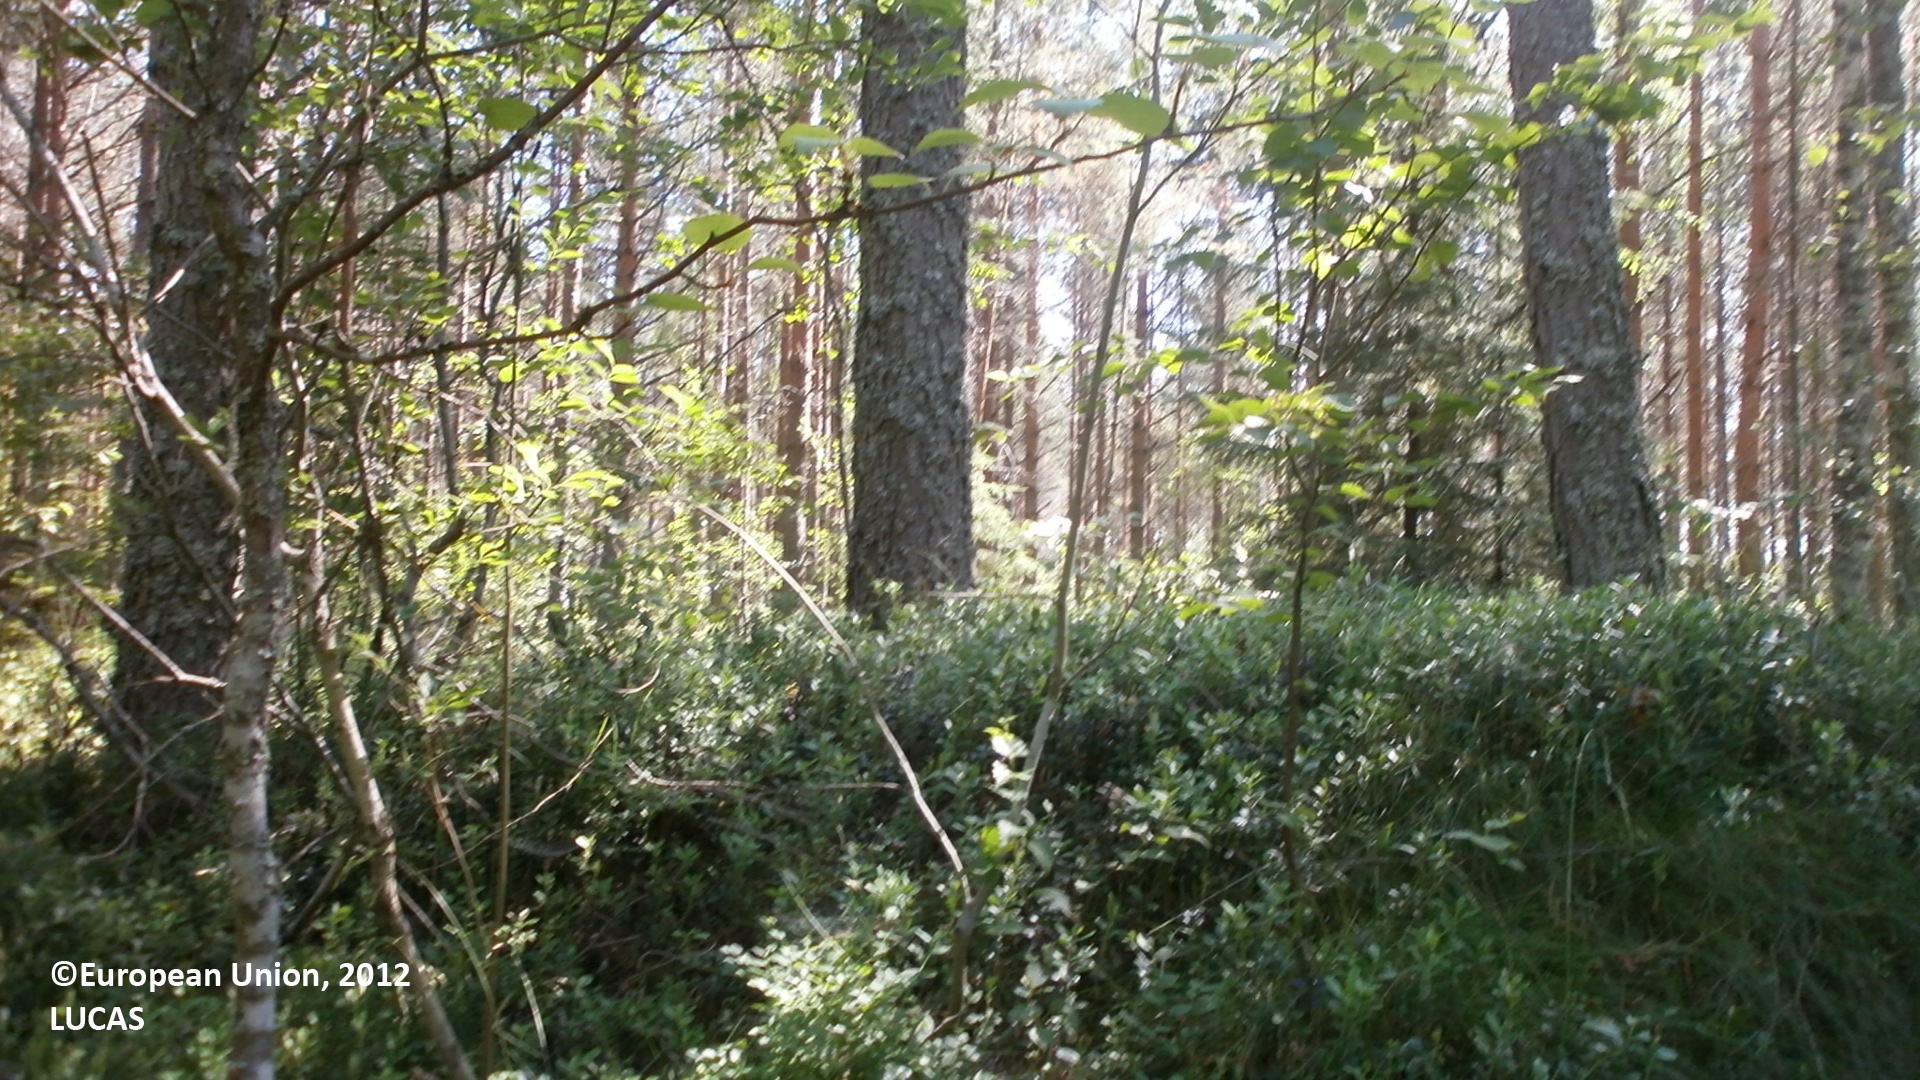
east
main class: Woodland
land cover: Pine dominated coniferous woodland
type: boreal forest
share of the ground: > 75 %
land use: Forestry
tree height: > 5 m
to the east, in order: Ditches and canals; Pine dominated coniferous woodland; Ditches and canals; Pine dominated coniferous woodland; Ditches and canals; Shruby margins; Oats
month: July
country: FI
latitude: 64.2950
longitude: 24.1368
